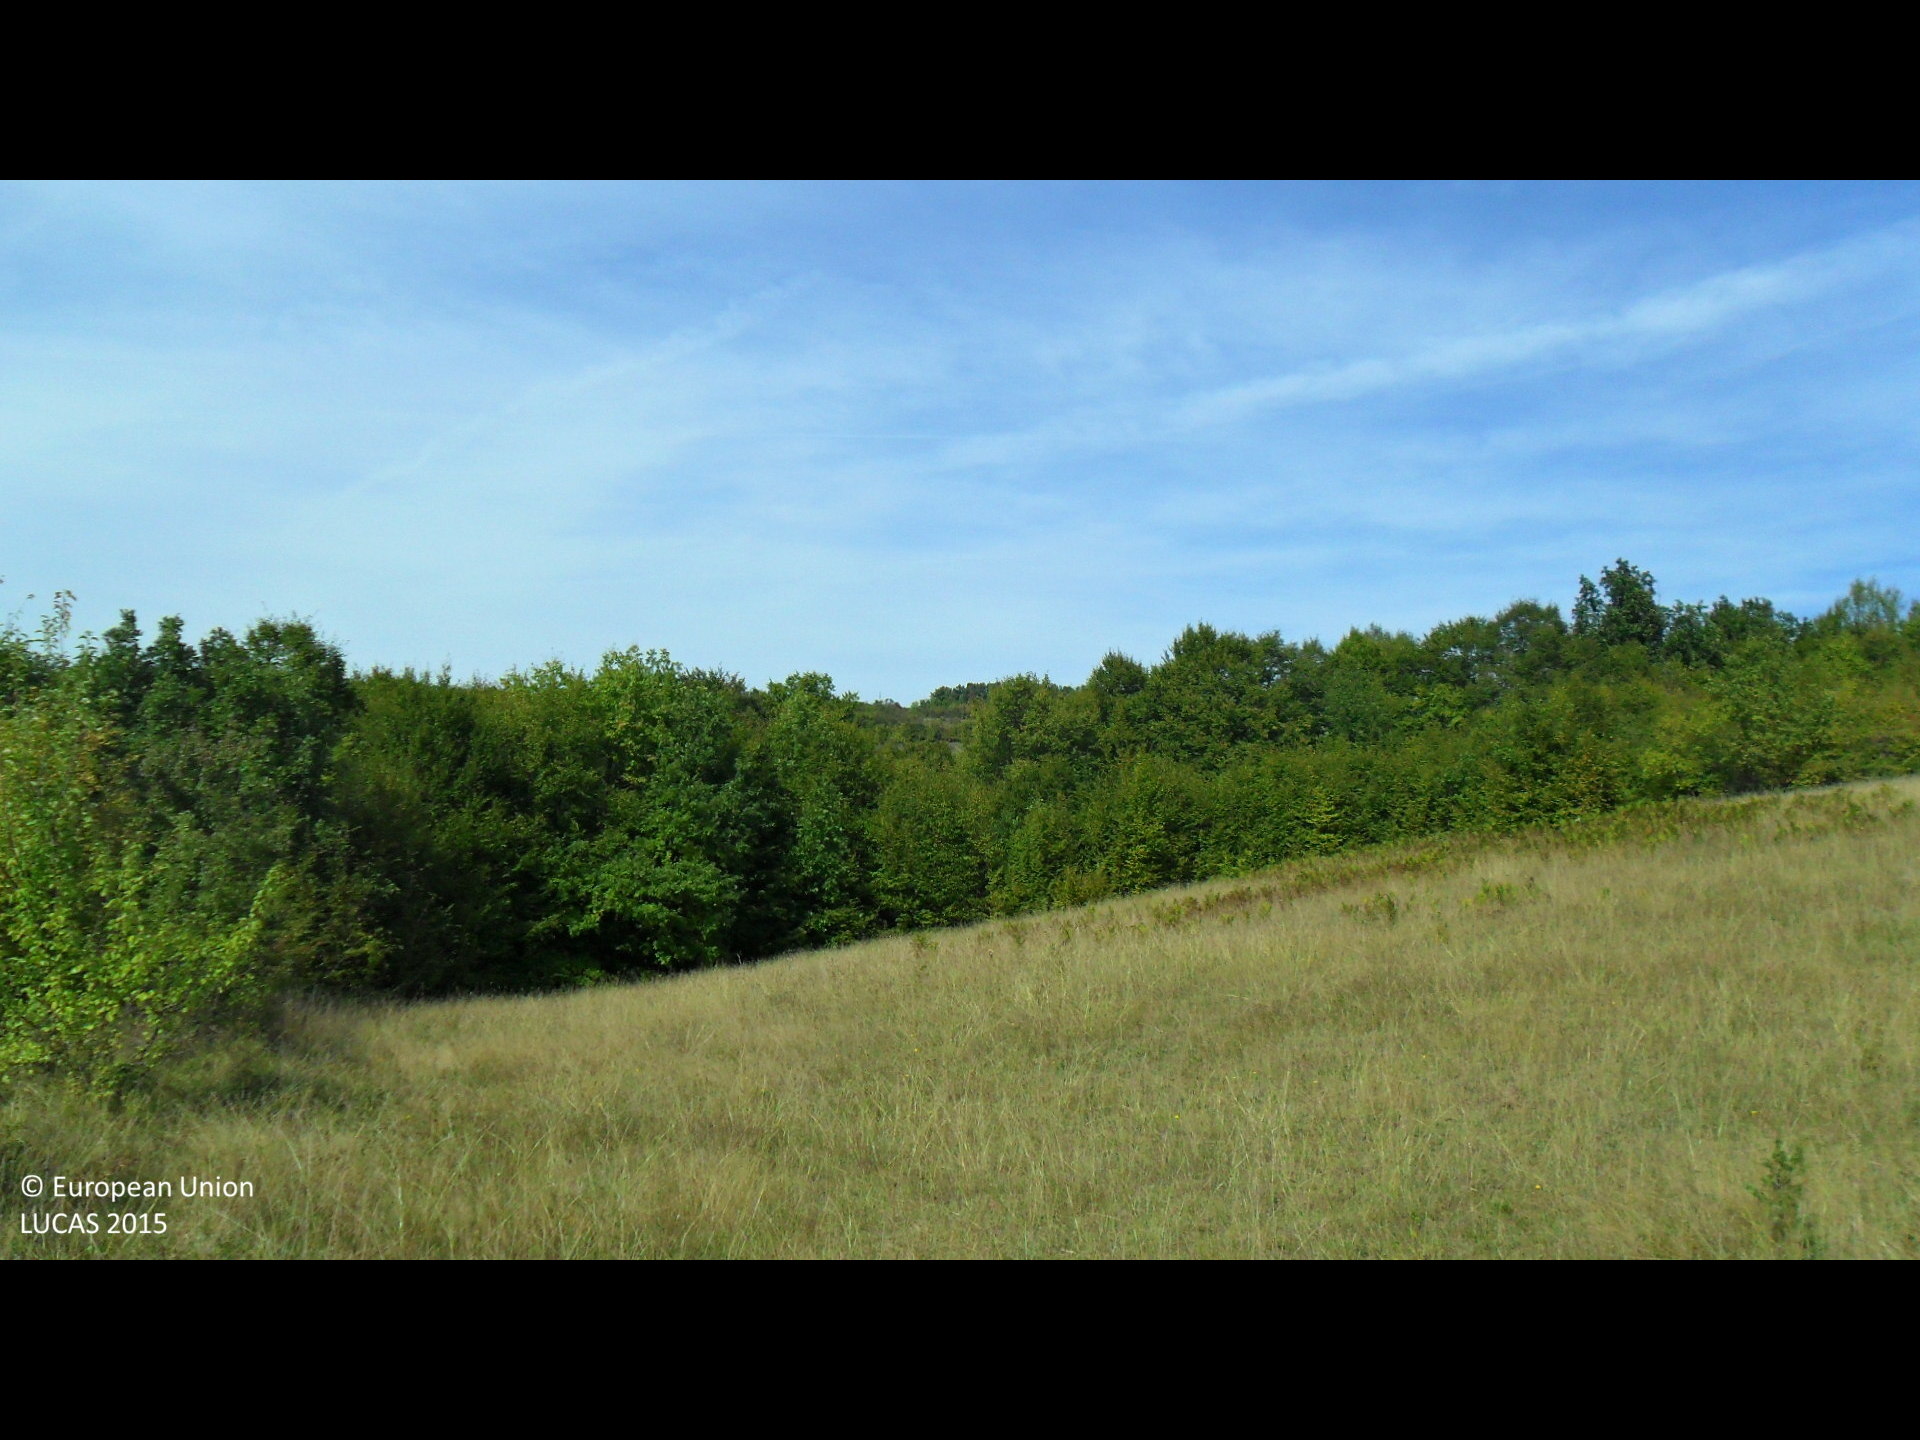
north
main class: Shrubland
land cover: Shrubland without tree cover
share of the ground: > 75 %
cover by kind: shrubs 80 %, herbaceous plants 20 %
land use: Agriculture (excluding fallow land and kitchen gardens)
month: October
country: BG
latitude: 42.9769
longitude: 26.1912
